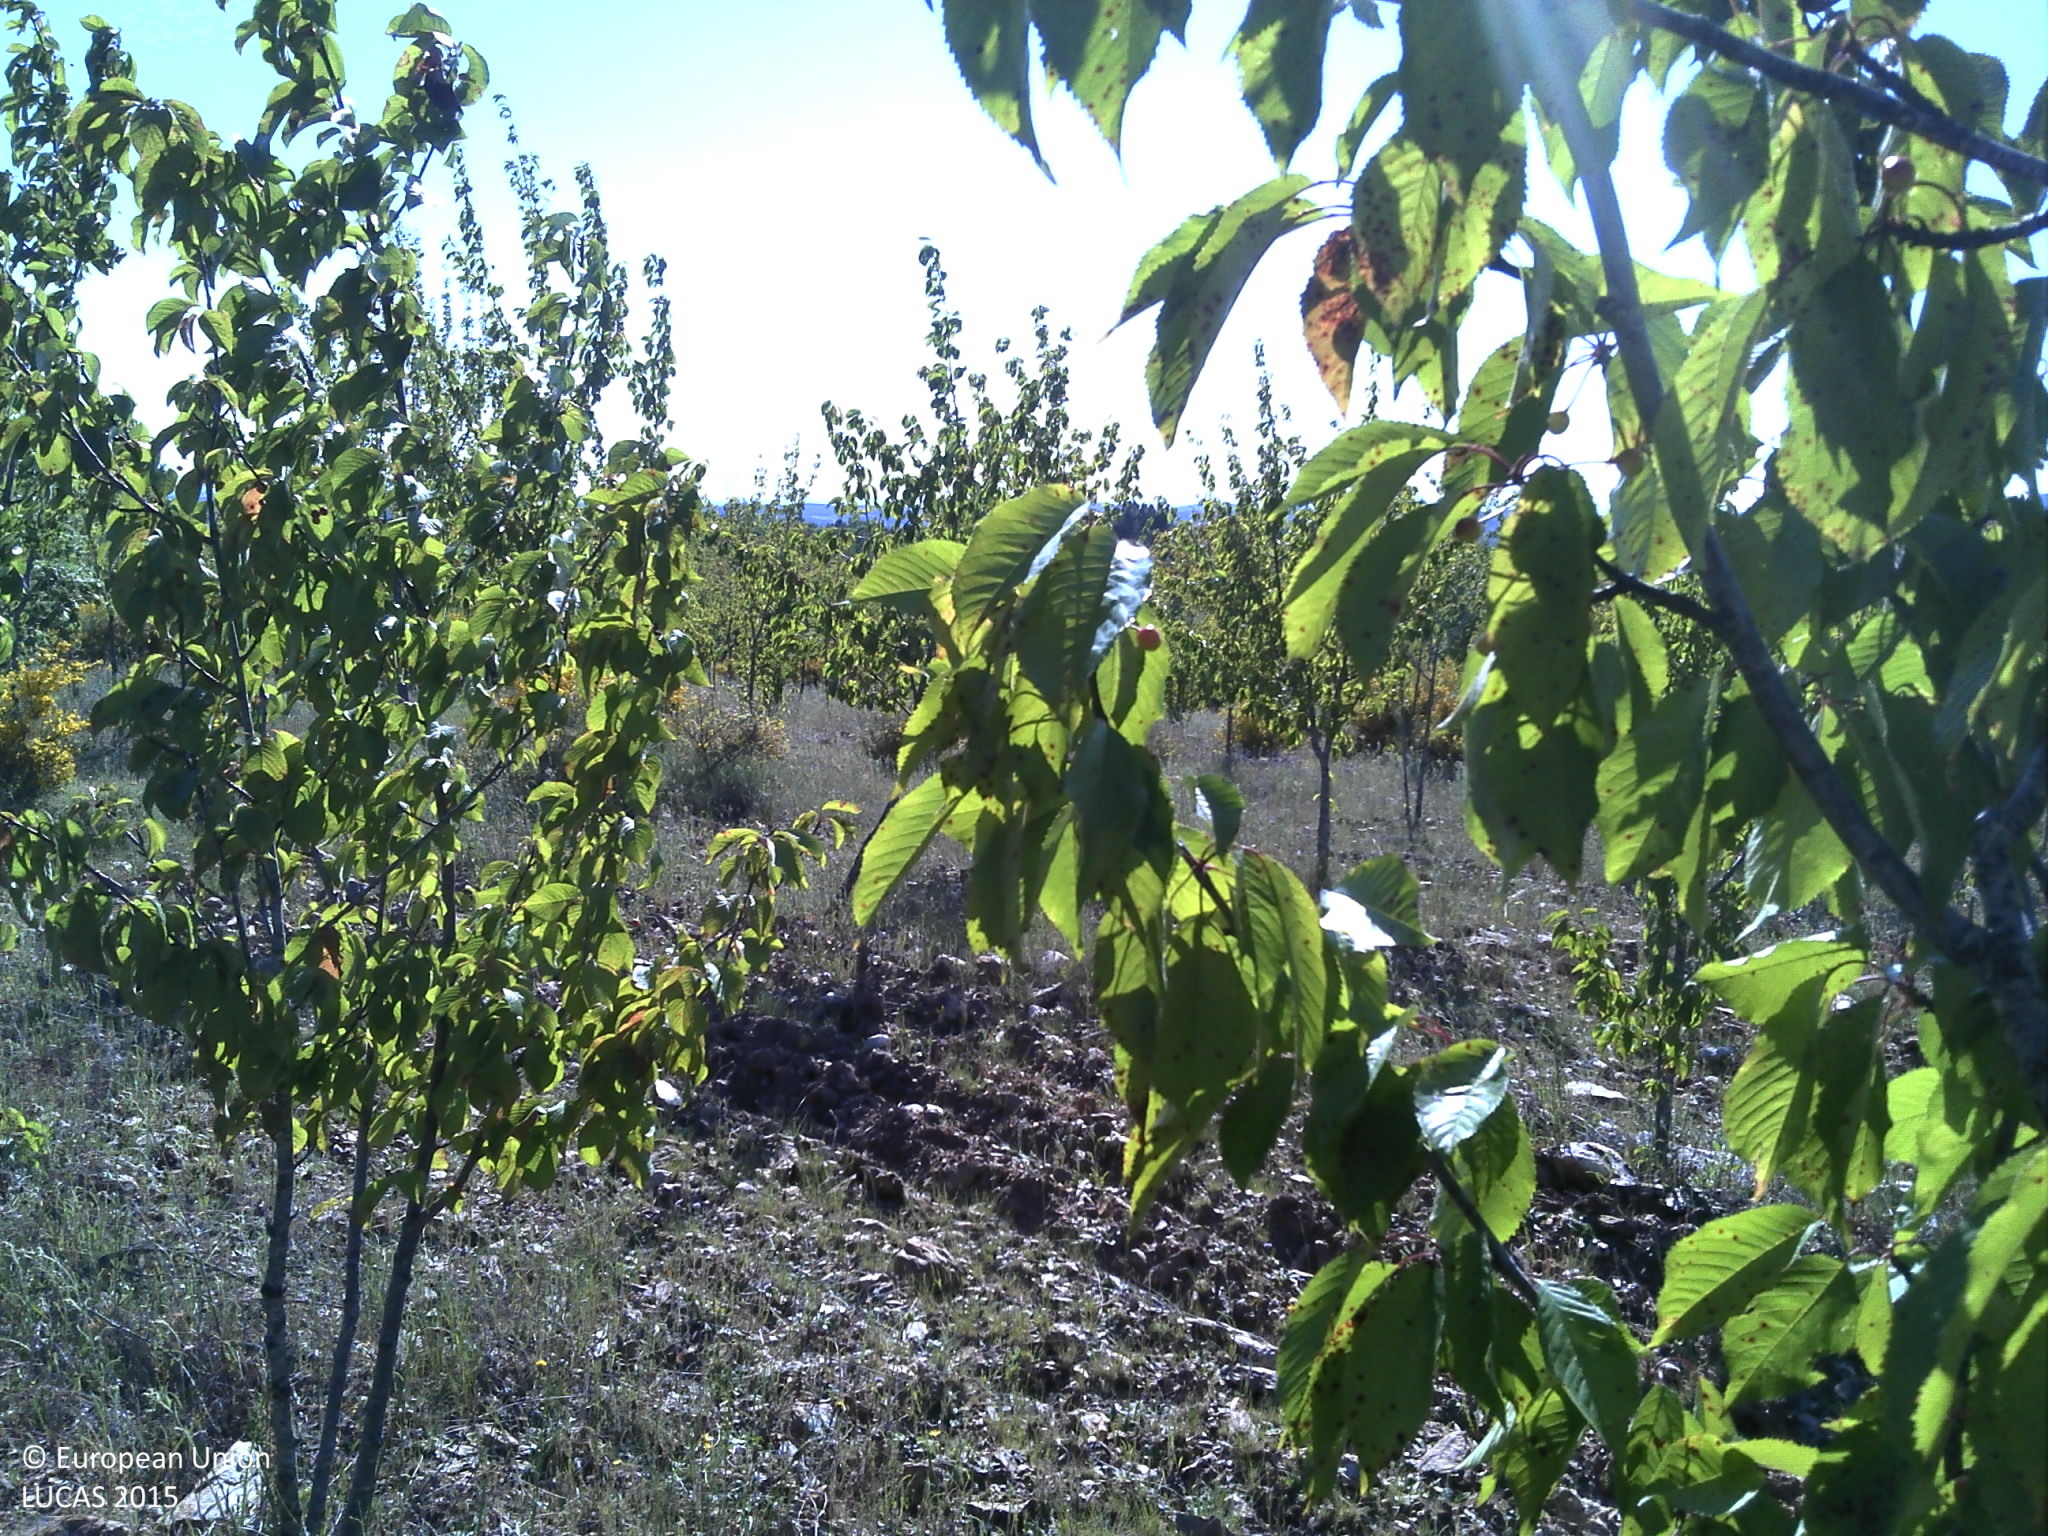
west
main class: Cropland
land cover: Cherry fruit
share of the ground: 25 - 50 %
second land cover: Spontaneously vegetated surfaces
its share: 25 - 50 %
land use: Agriculture (excluding fallow land and kitchen gardens)
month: May
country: PT
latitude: 41.6564
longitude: -6.3981
